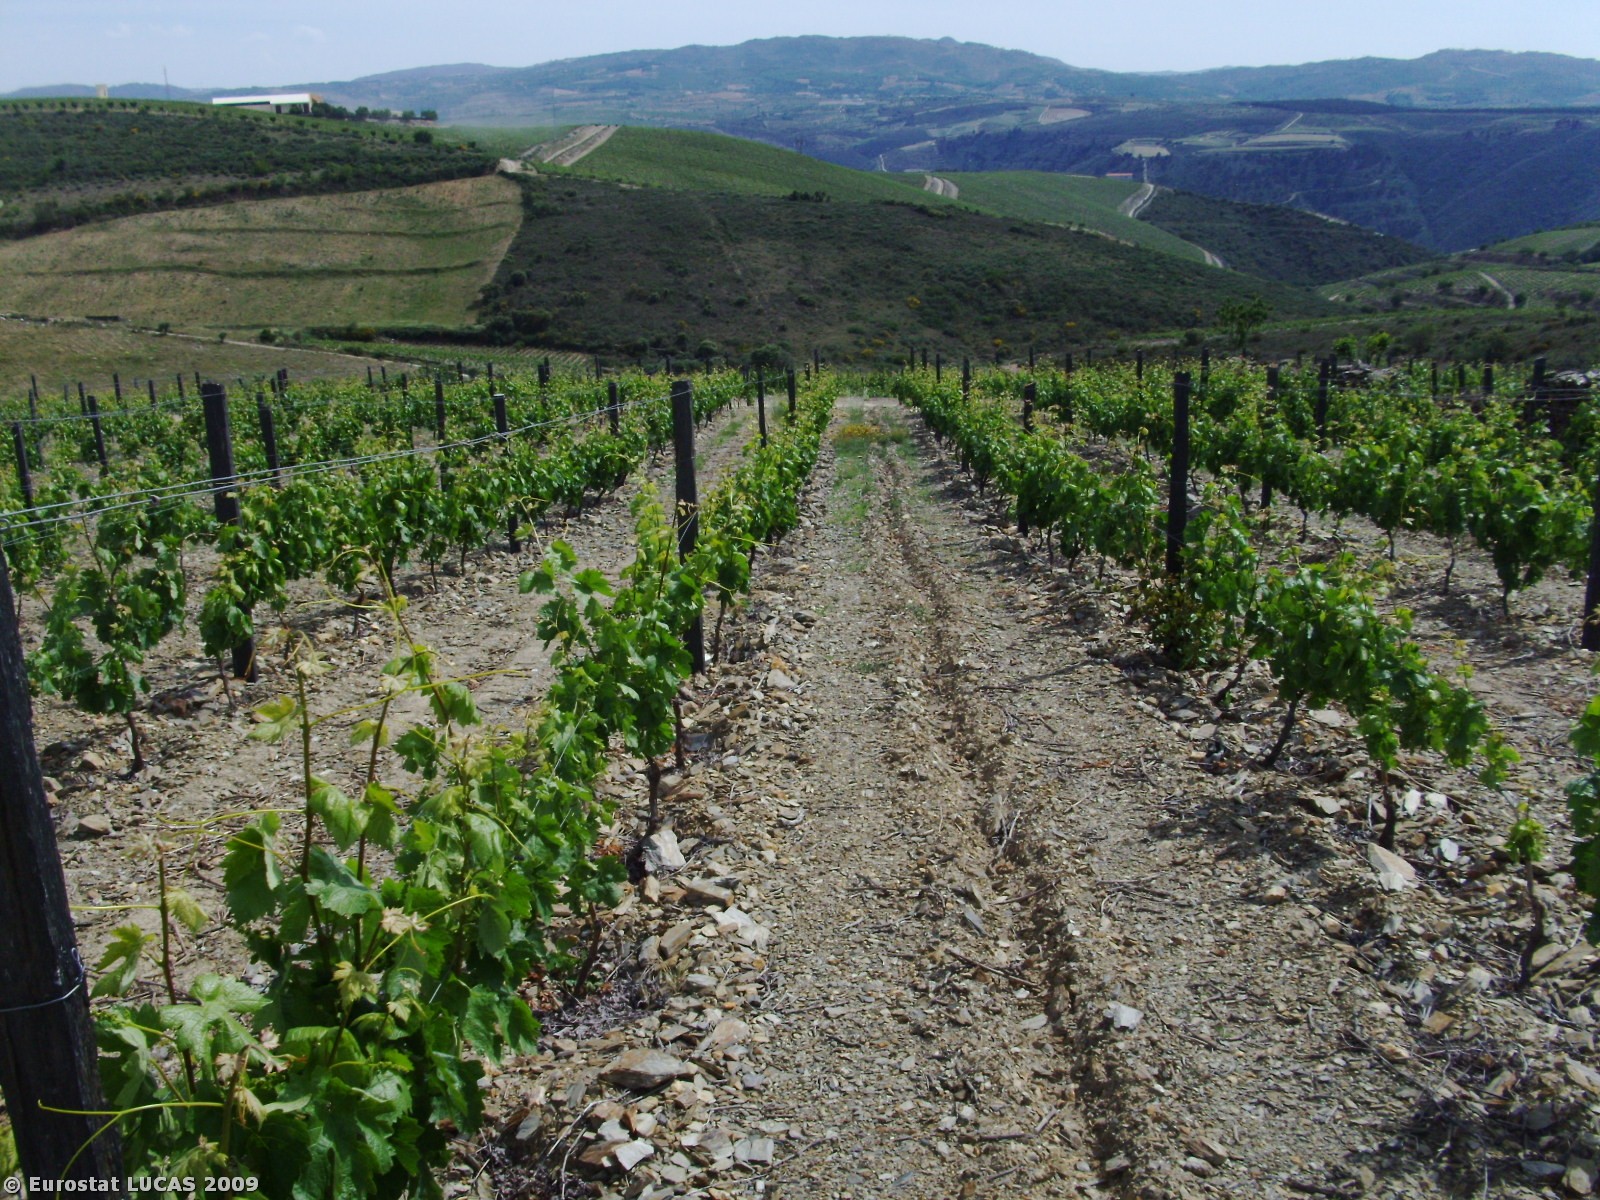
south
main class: Cropland
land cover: Vineyards
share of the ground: 25 - 50 %
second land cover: Bare land
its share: 50 - 75 %
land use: Agriculture (excluding fallow land and kitchen gardens)
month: May
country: PT
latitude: 41.1335
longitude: -7.4041
